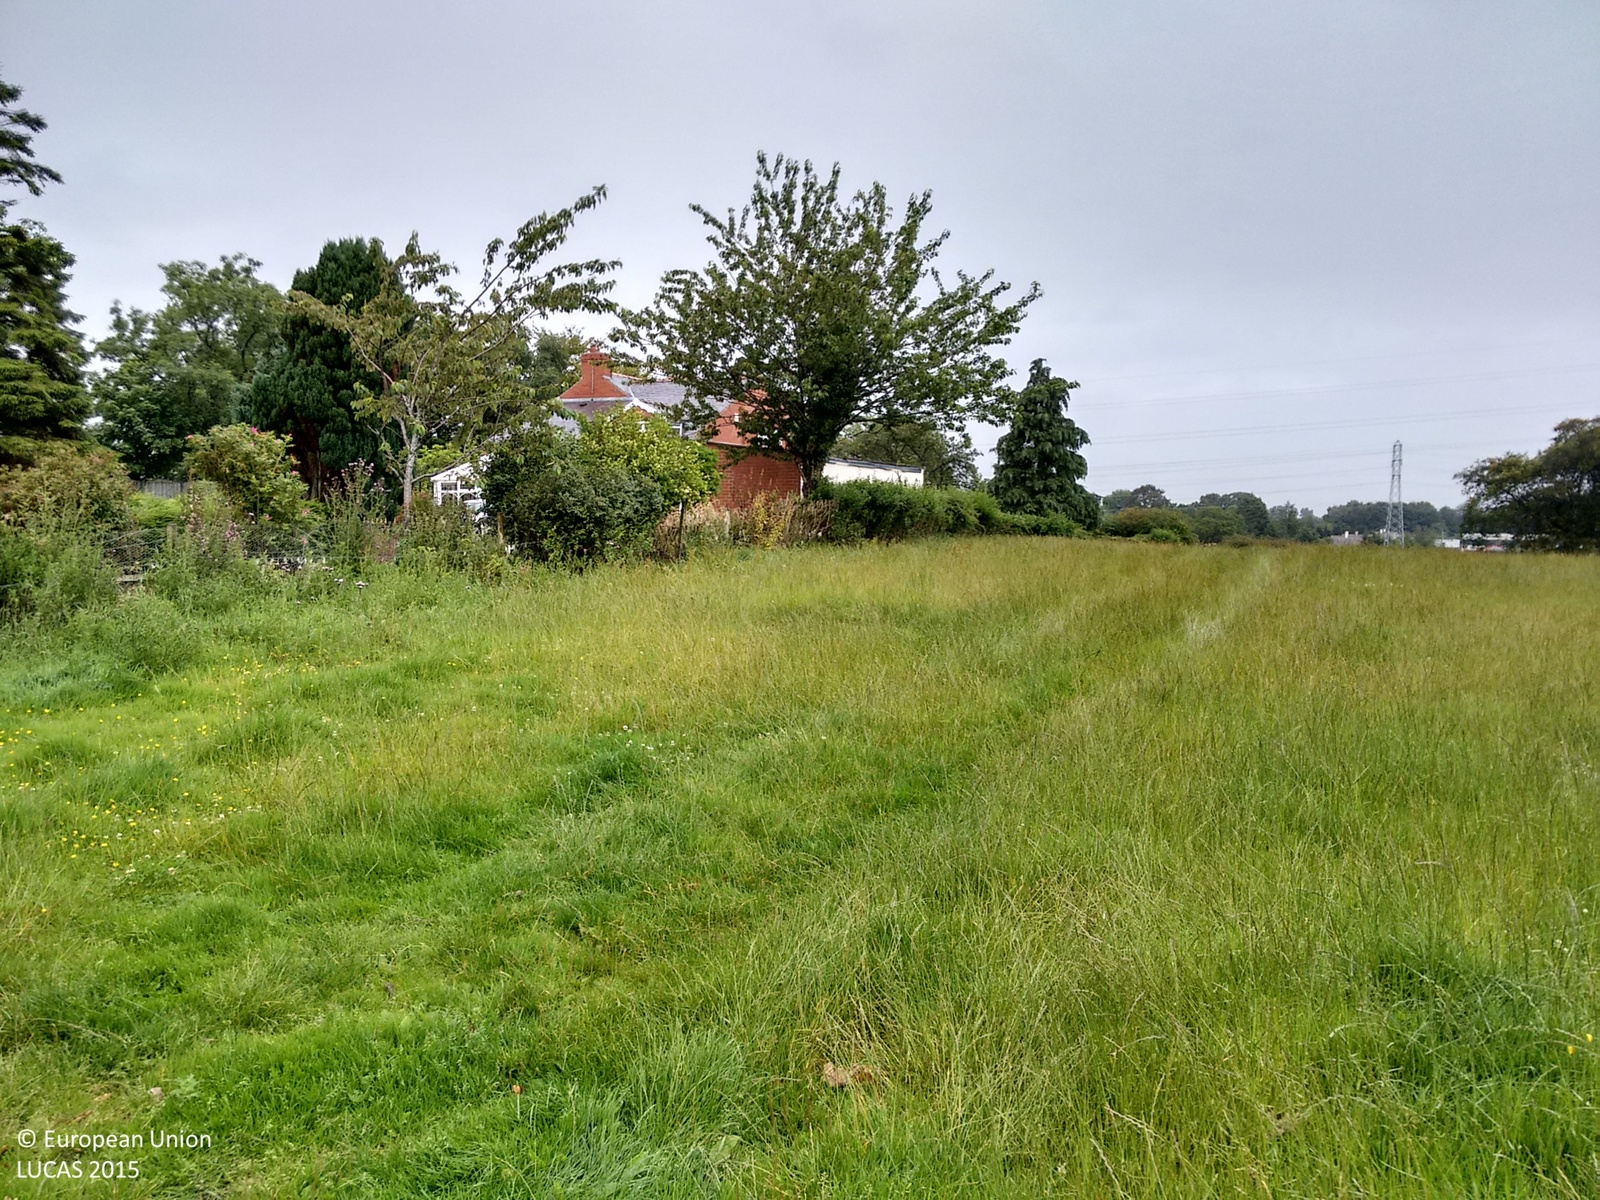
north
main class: Cropland
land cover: Temporary grasslands
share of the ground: > 75 %
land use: Agriculture (excluding fallow land and kitchen gardens)
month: July
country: GB
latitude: 54.8675
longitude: -2.9885
